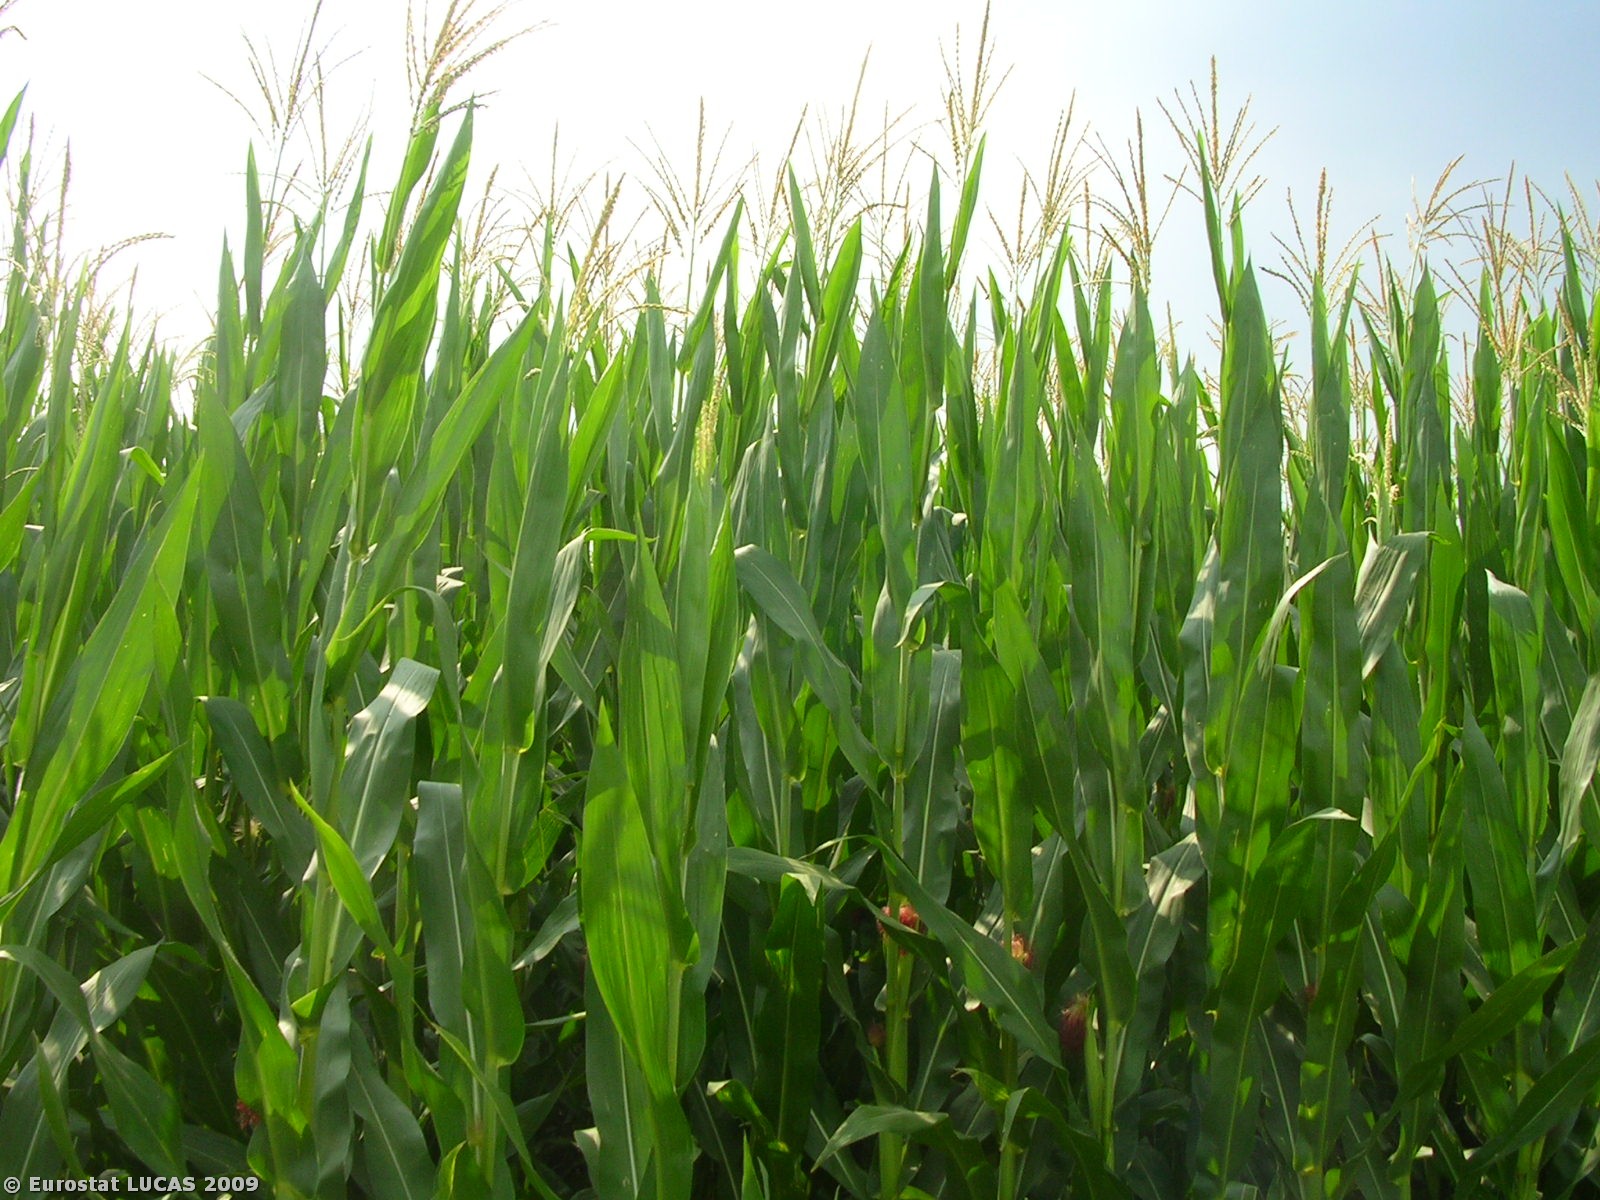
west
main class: Cropland
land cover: Maize
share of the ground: > 75 %
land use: Agriculture (excluding fallow land and kitchen gardens)
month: July
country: IT
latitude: 45.1672
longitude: 11.6383
